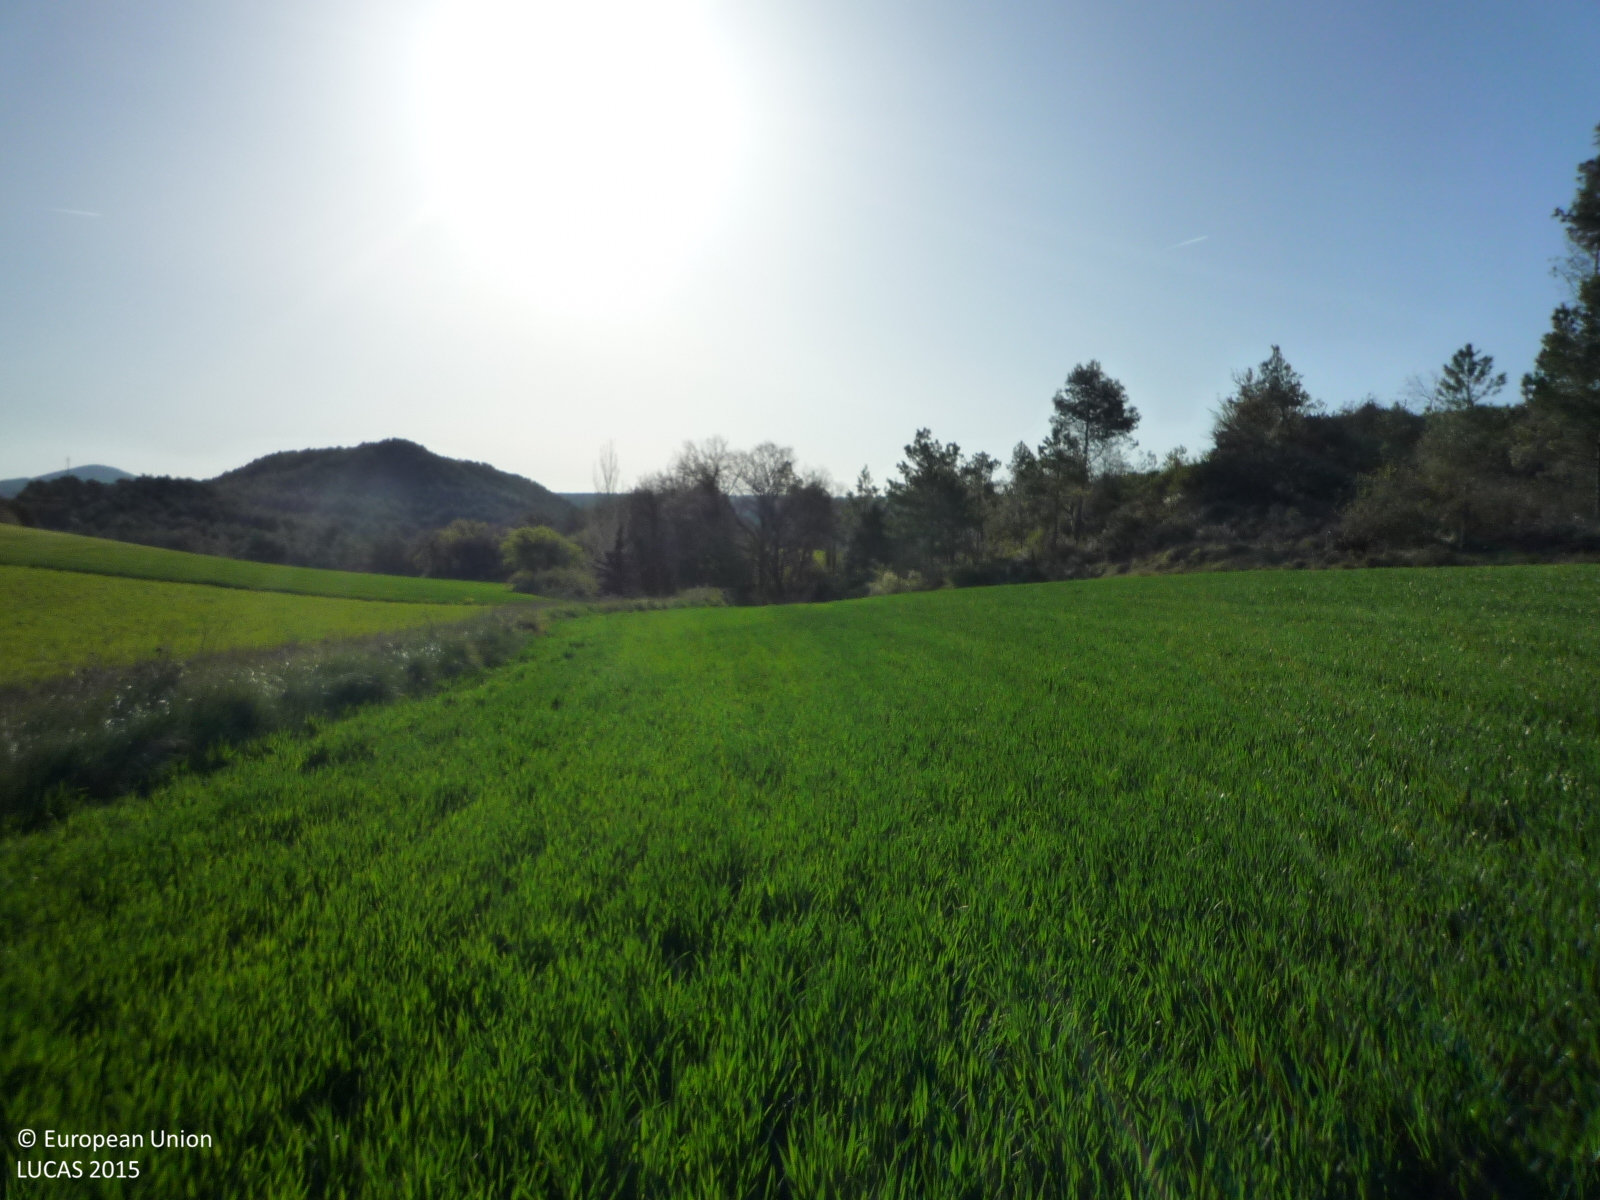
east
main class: Cropland
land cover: Common wheat
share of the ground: > 75 %
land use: Agriculture (excluding fallow land and kitchen gardens)
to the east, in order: Common wheat; Shruby margins; Grass margins; Tracks; Grass margins; Oats; Barley; Electric lines; Barley; Shruby margins; Broadleaved woodland; Barley
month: April
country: ES
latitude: 41.4972
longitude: 1.4988
